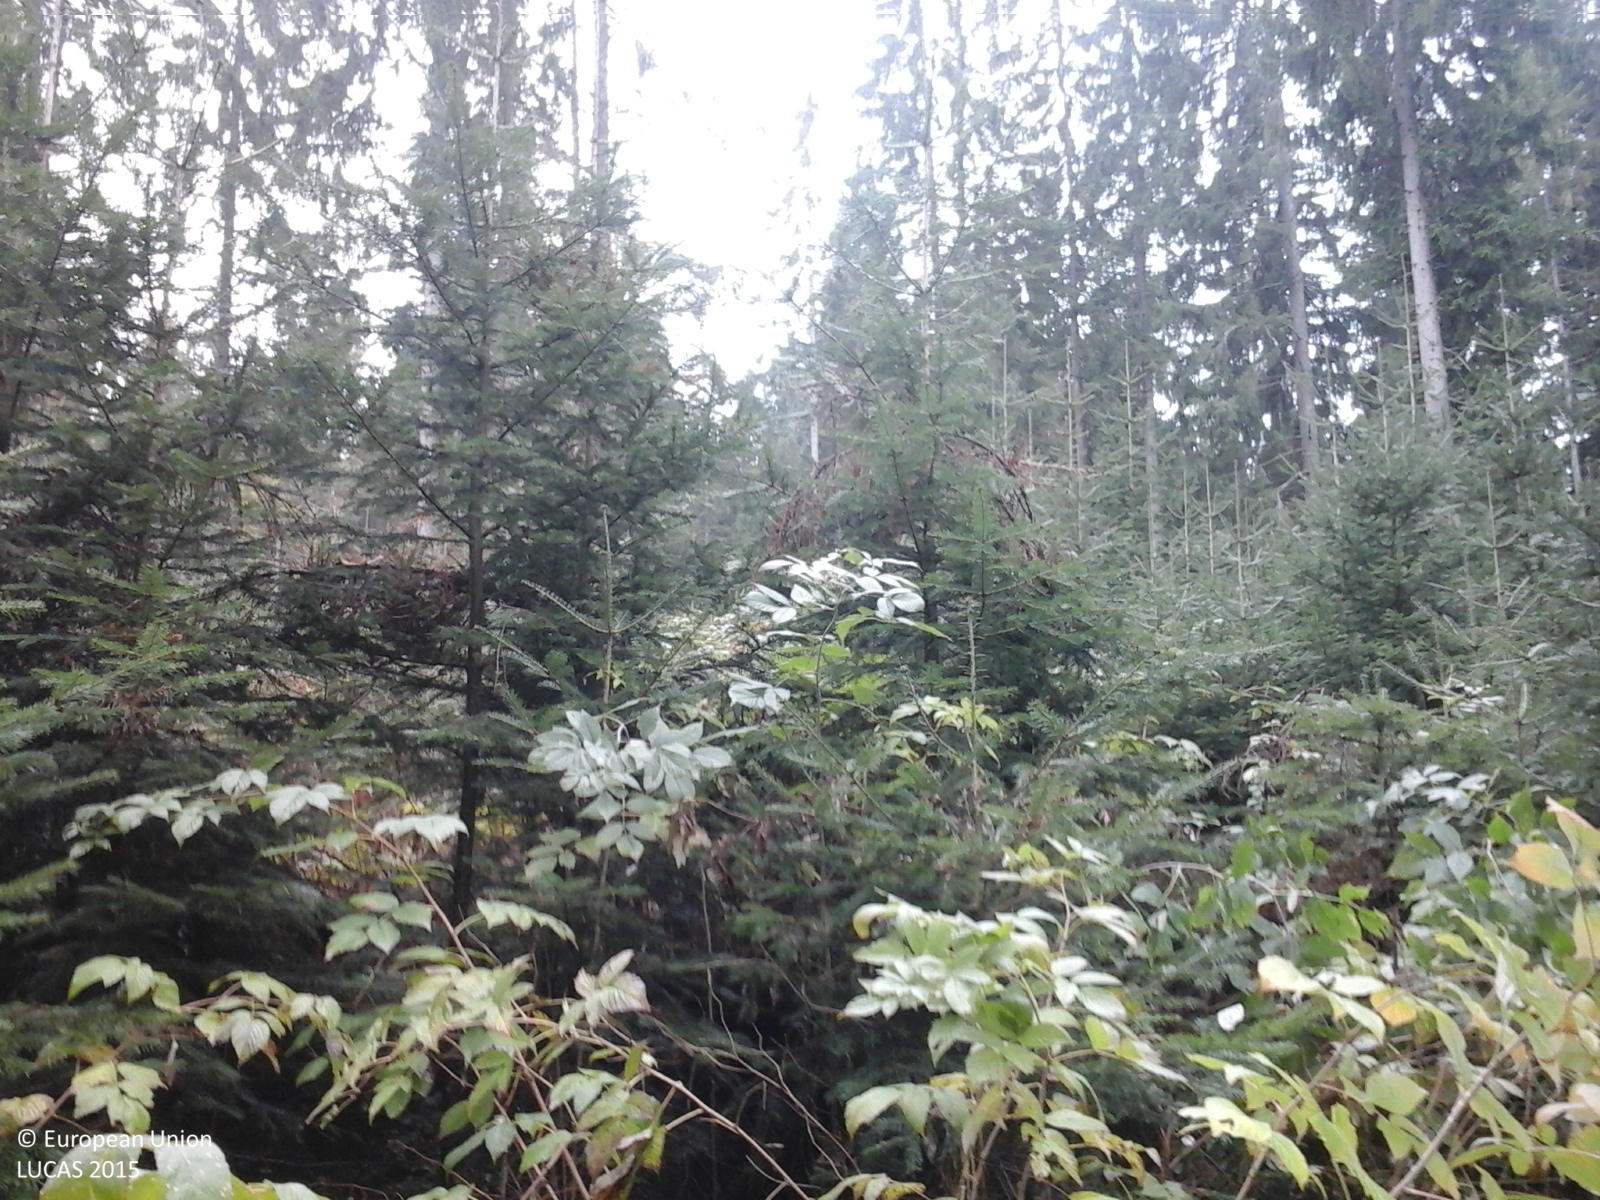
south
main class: Woodland
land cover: Other coniferous woodland
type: alpine coniferous forest
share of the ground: > 75 %
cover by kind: coniferous forest trees 75 %, broadleaved forest trees 10 %, herbaceous plants 10 %, shrubs 5 %
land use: Forestry
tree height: > 5 m
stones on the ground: < 10 %
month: October
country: RO
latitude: 46.8319
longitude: 25.3281
